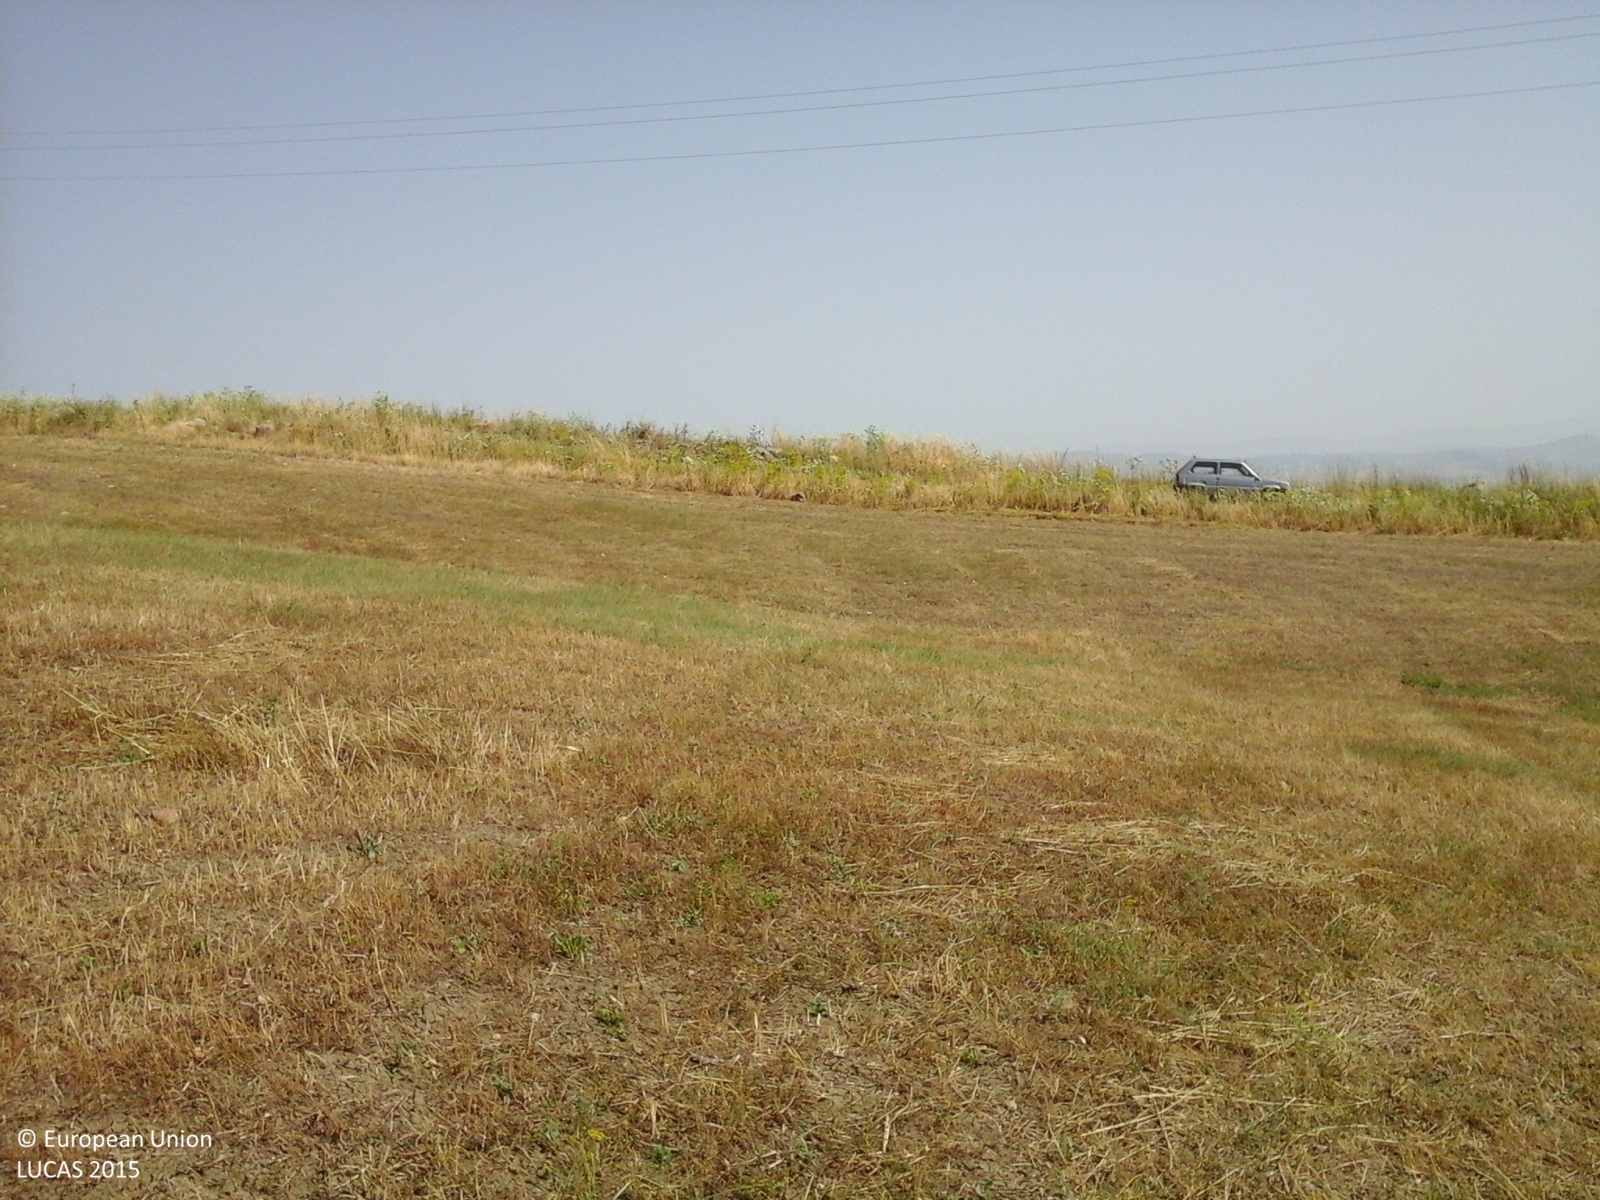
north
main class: Cropland
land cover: Durum wheat
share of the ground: > 75 %
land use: Agriculture (excluding fallow land and kitchen gardens)
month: June
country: IT
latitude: 37.4997
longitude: 14.4128
